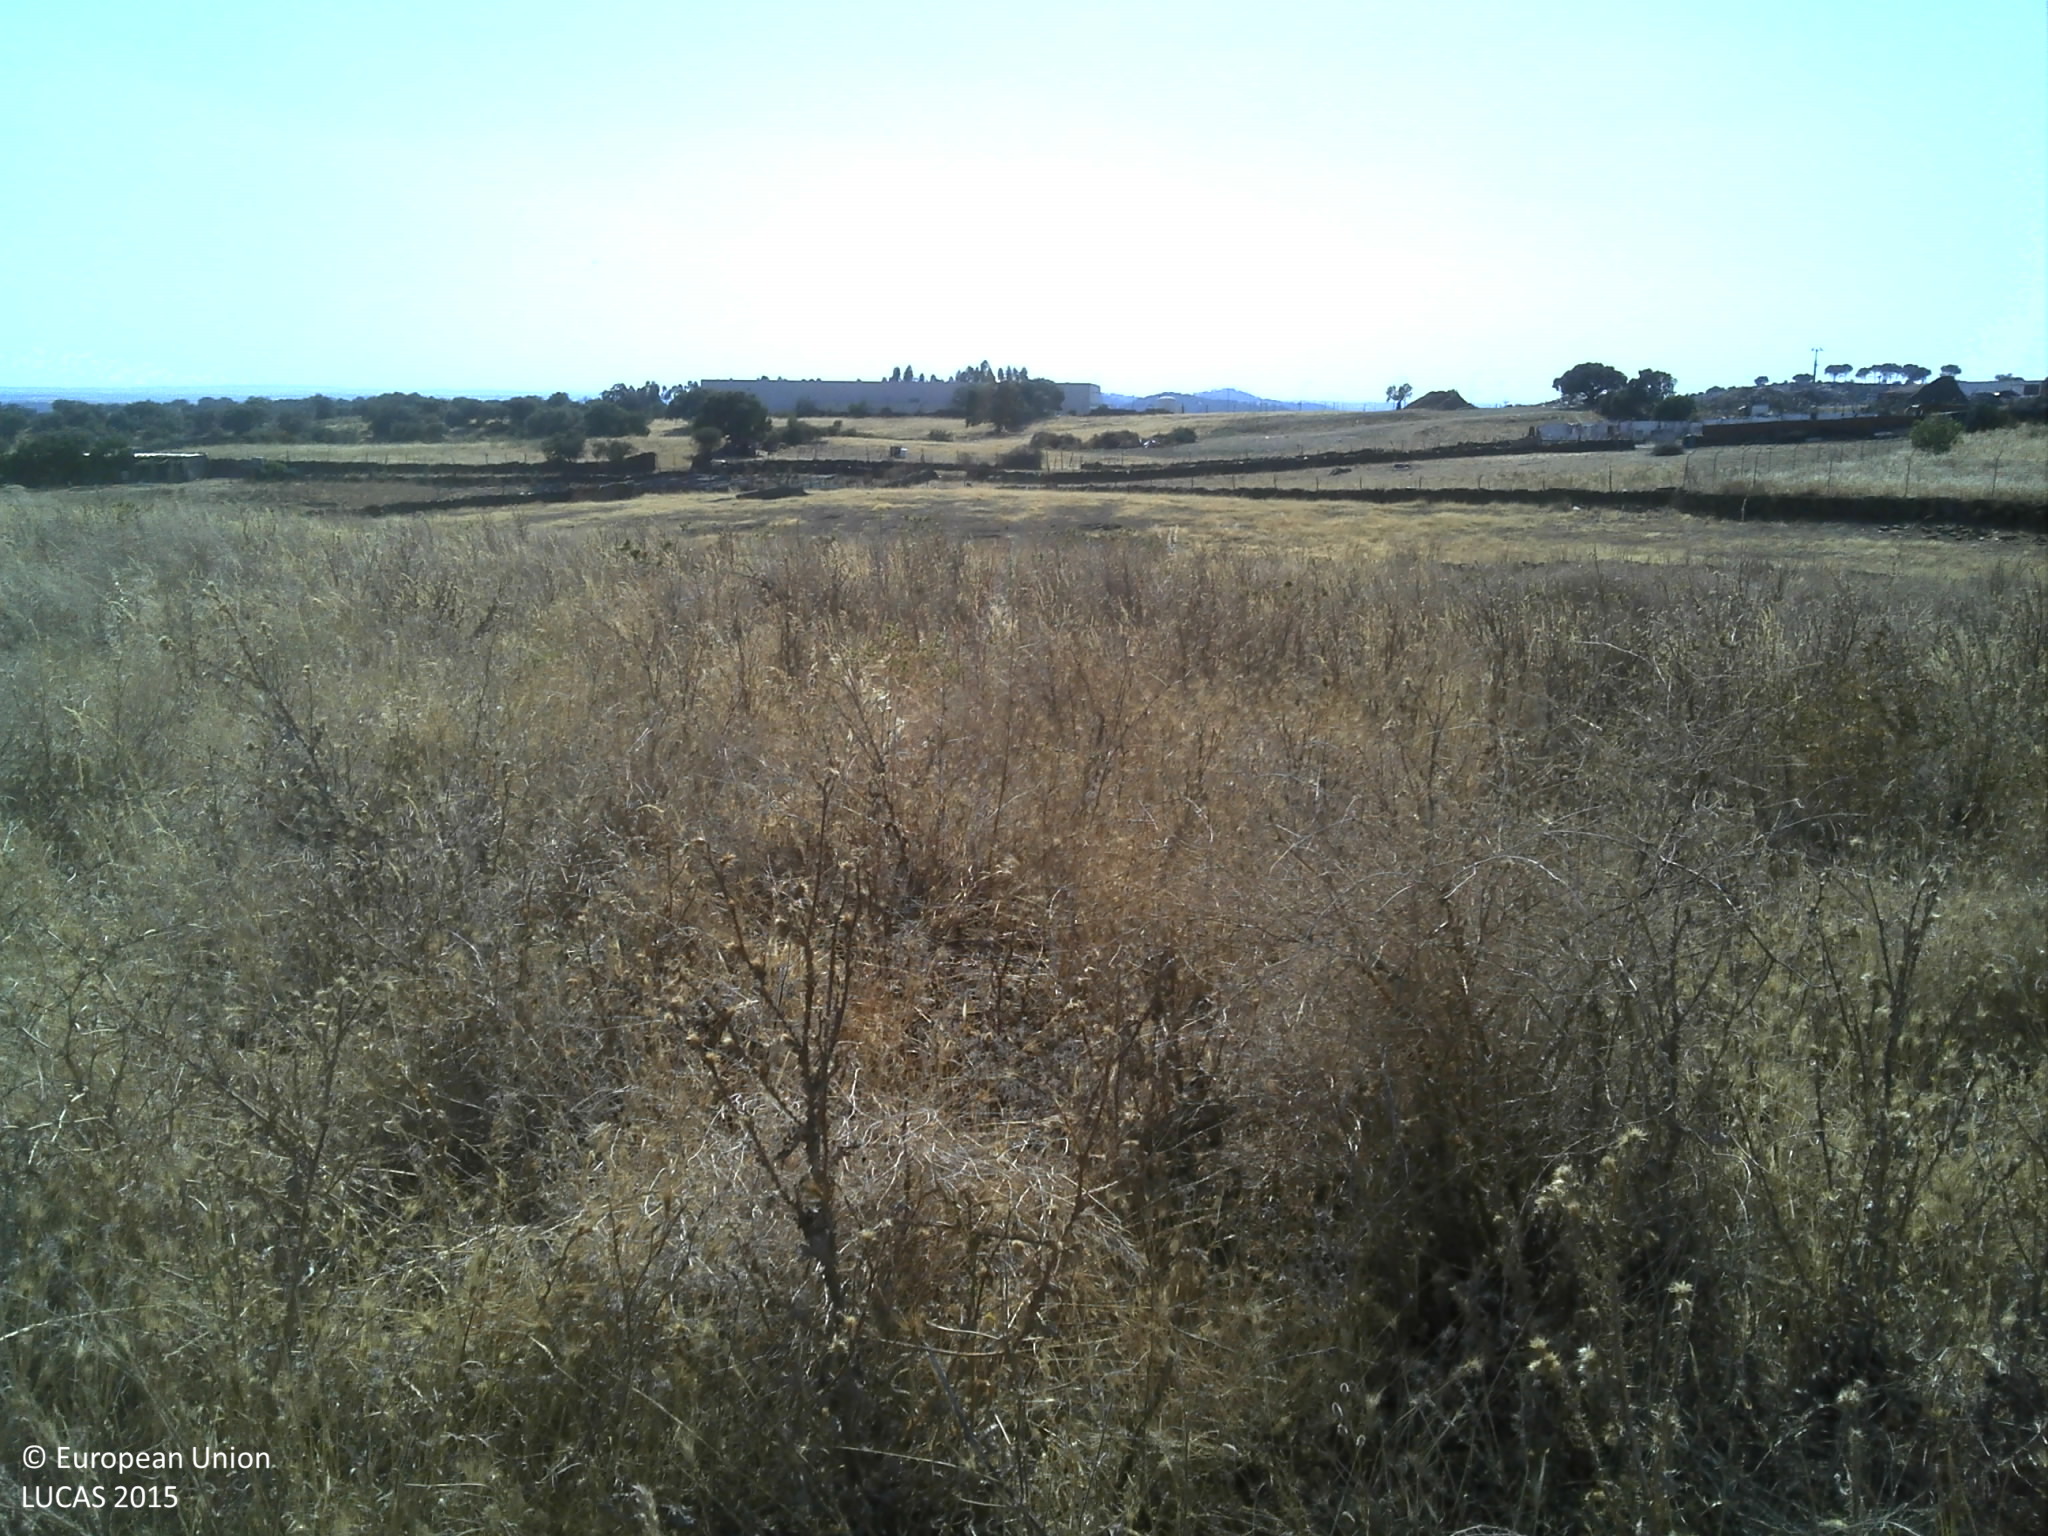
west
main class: Grassland
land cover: Grassland with sparse tree/shrub cover
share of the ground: > 75 %
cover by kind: herbaceous plants 95 %, broadleaved forest trees 5 %
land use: Agriculture (excluding fallow land and kitchen gardens)
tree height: < 5 m
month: June
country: PT
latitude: 38.3772
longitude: -7.3420
